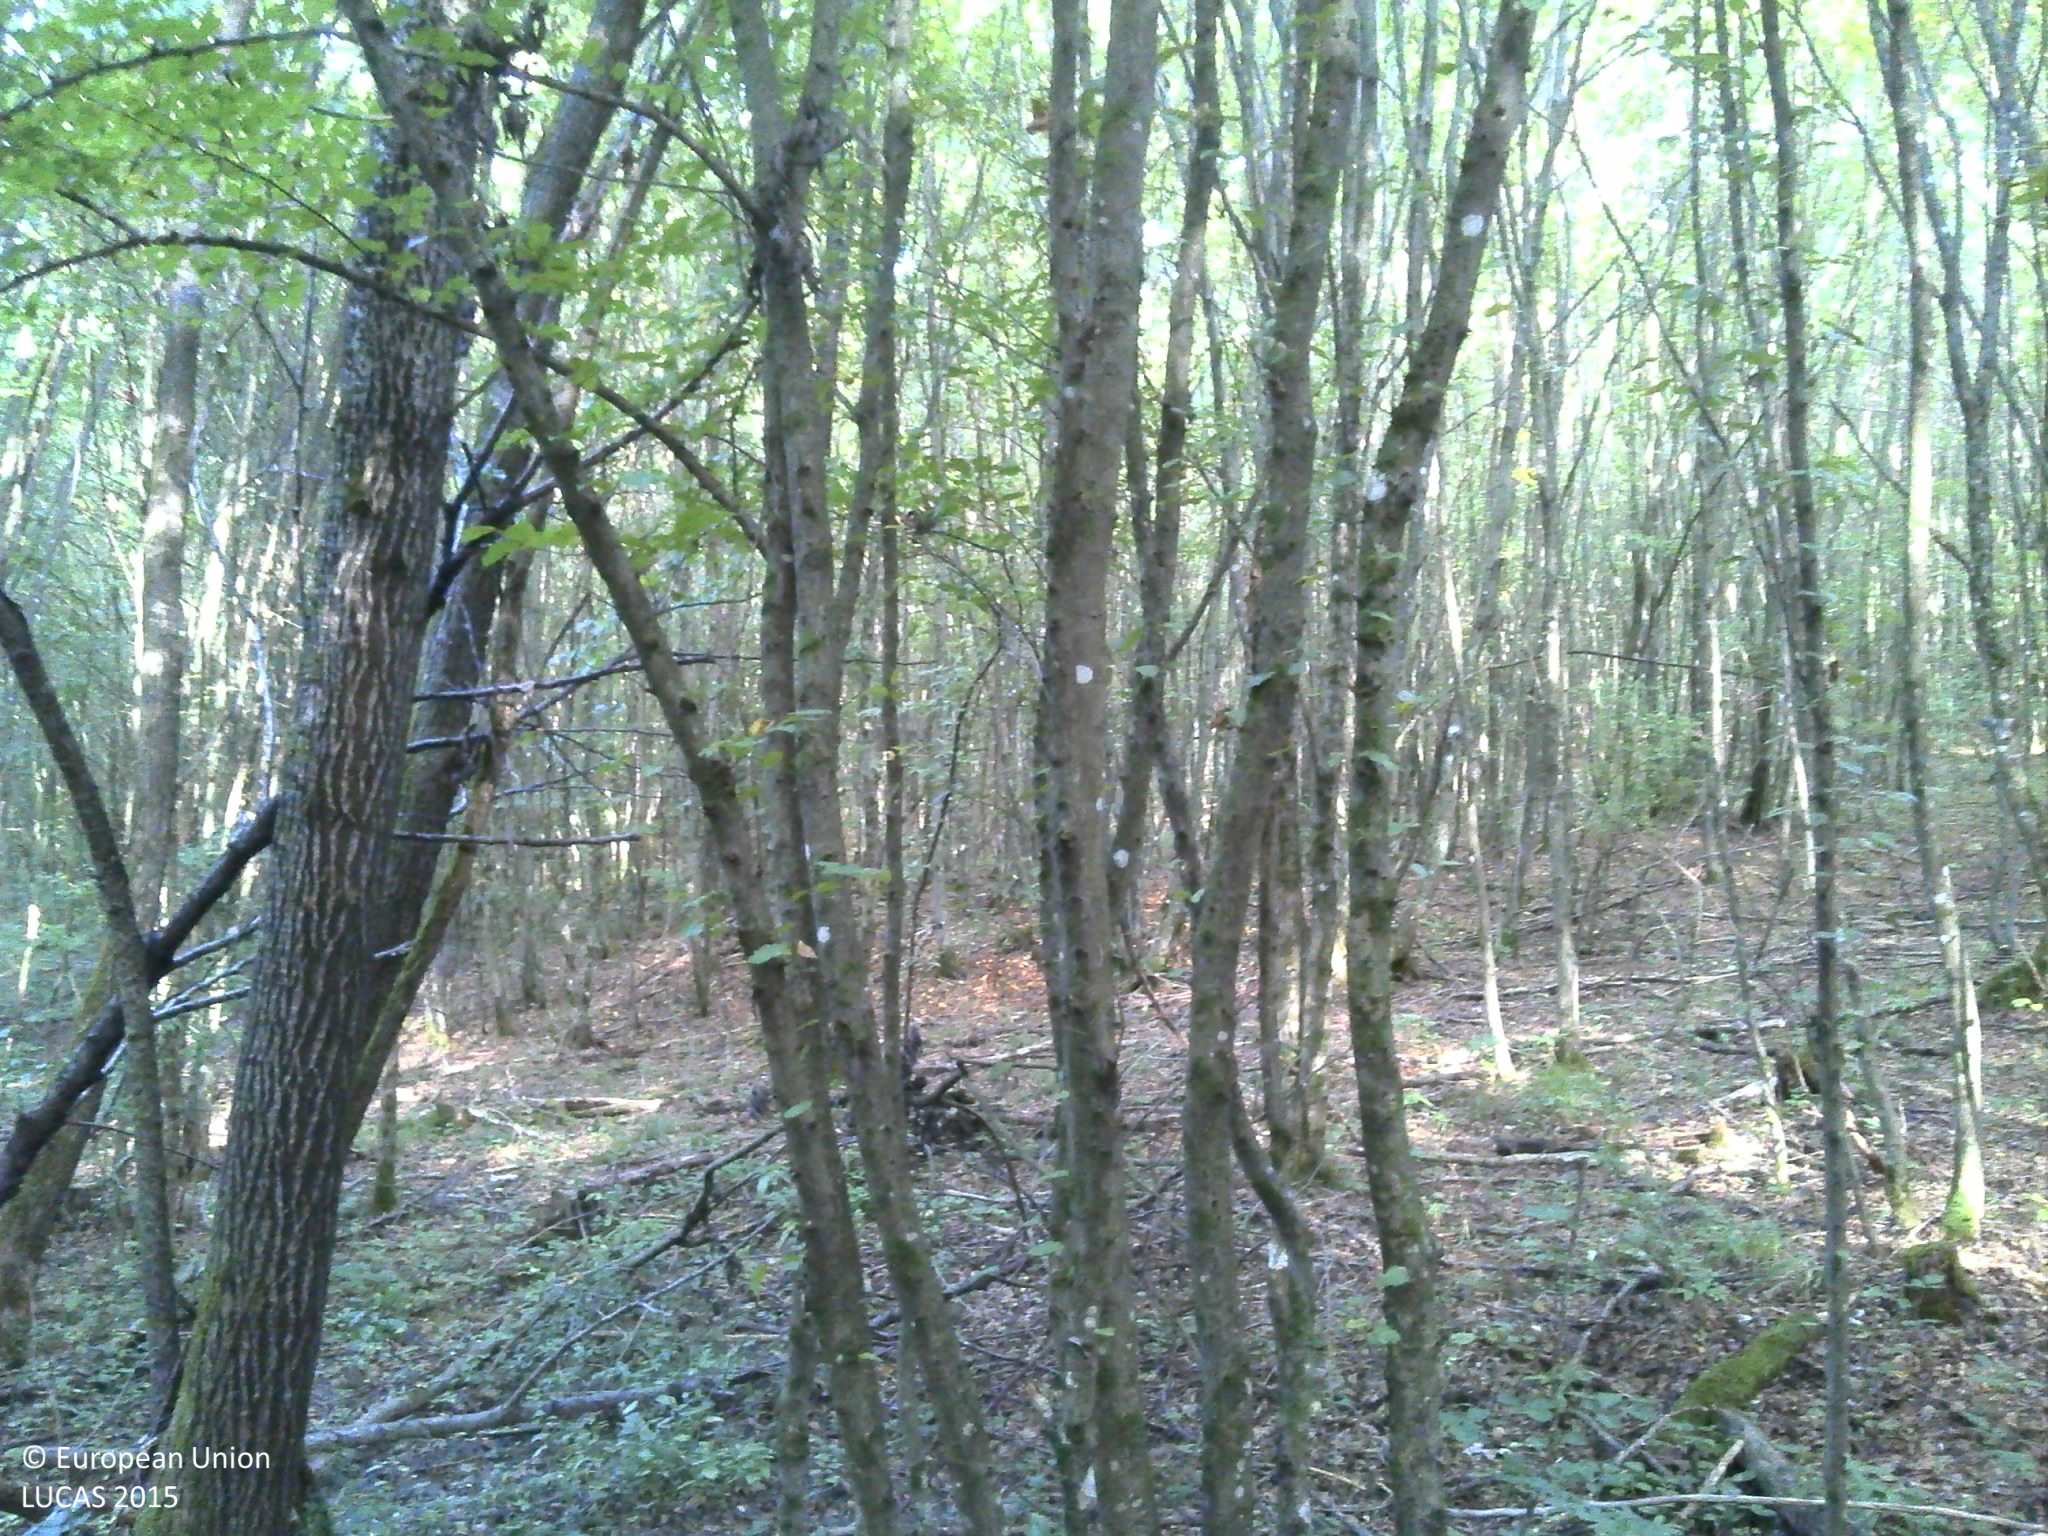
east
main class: Woodland
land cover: Broadleaved woodland
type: acidophilous oak and oak-birch forest
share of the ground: > 75 %
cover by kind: broadleaved forest trees 100 %
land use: Forestry
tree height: > 5 m
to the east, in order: Broadleaved woodland
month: September
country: HR
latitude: 45.4891
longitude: 16.1262
